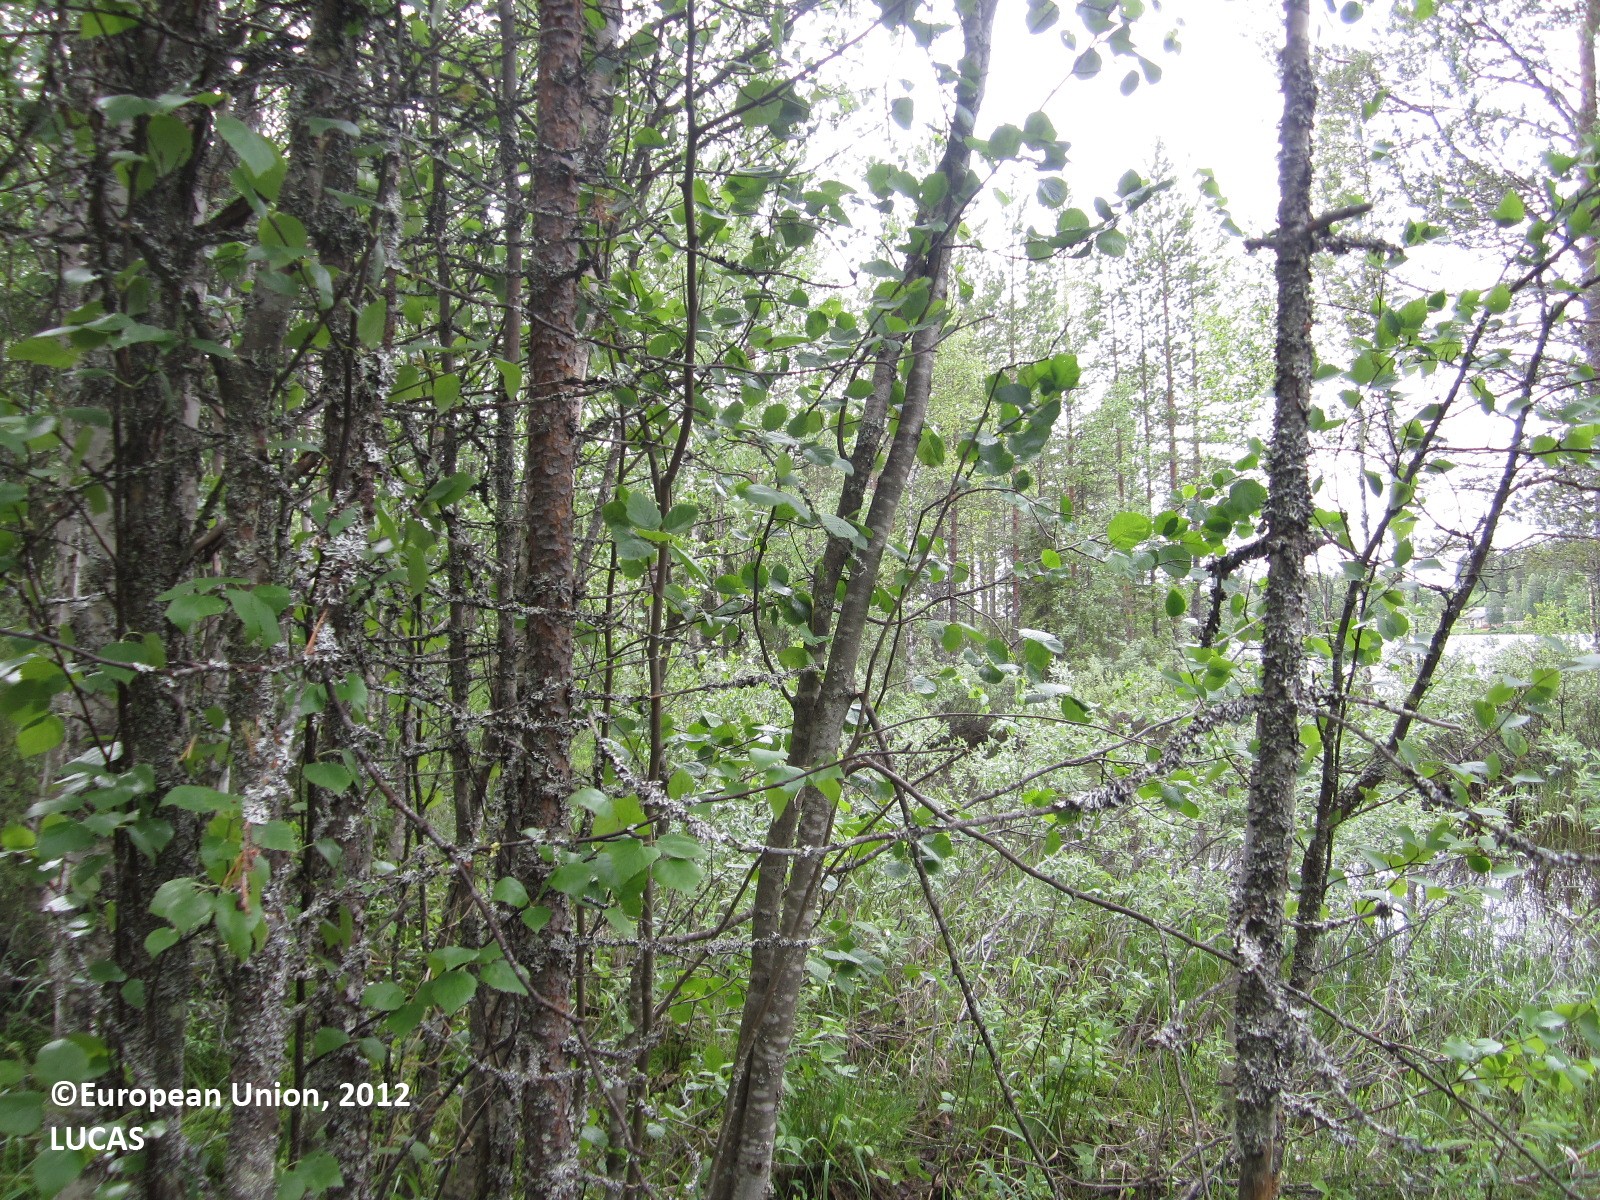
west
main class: Woodland
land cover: Broadleaved woodland
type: non-riverine alder, birch or aspen forest
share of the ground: > 75 %
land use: Forestry
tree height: > 5 m
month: June
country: FI
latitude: 64.4643
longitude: 29.9205
